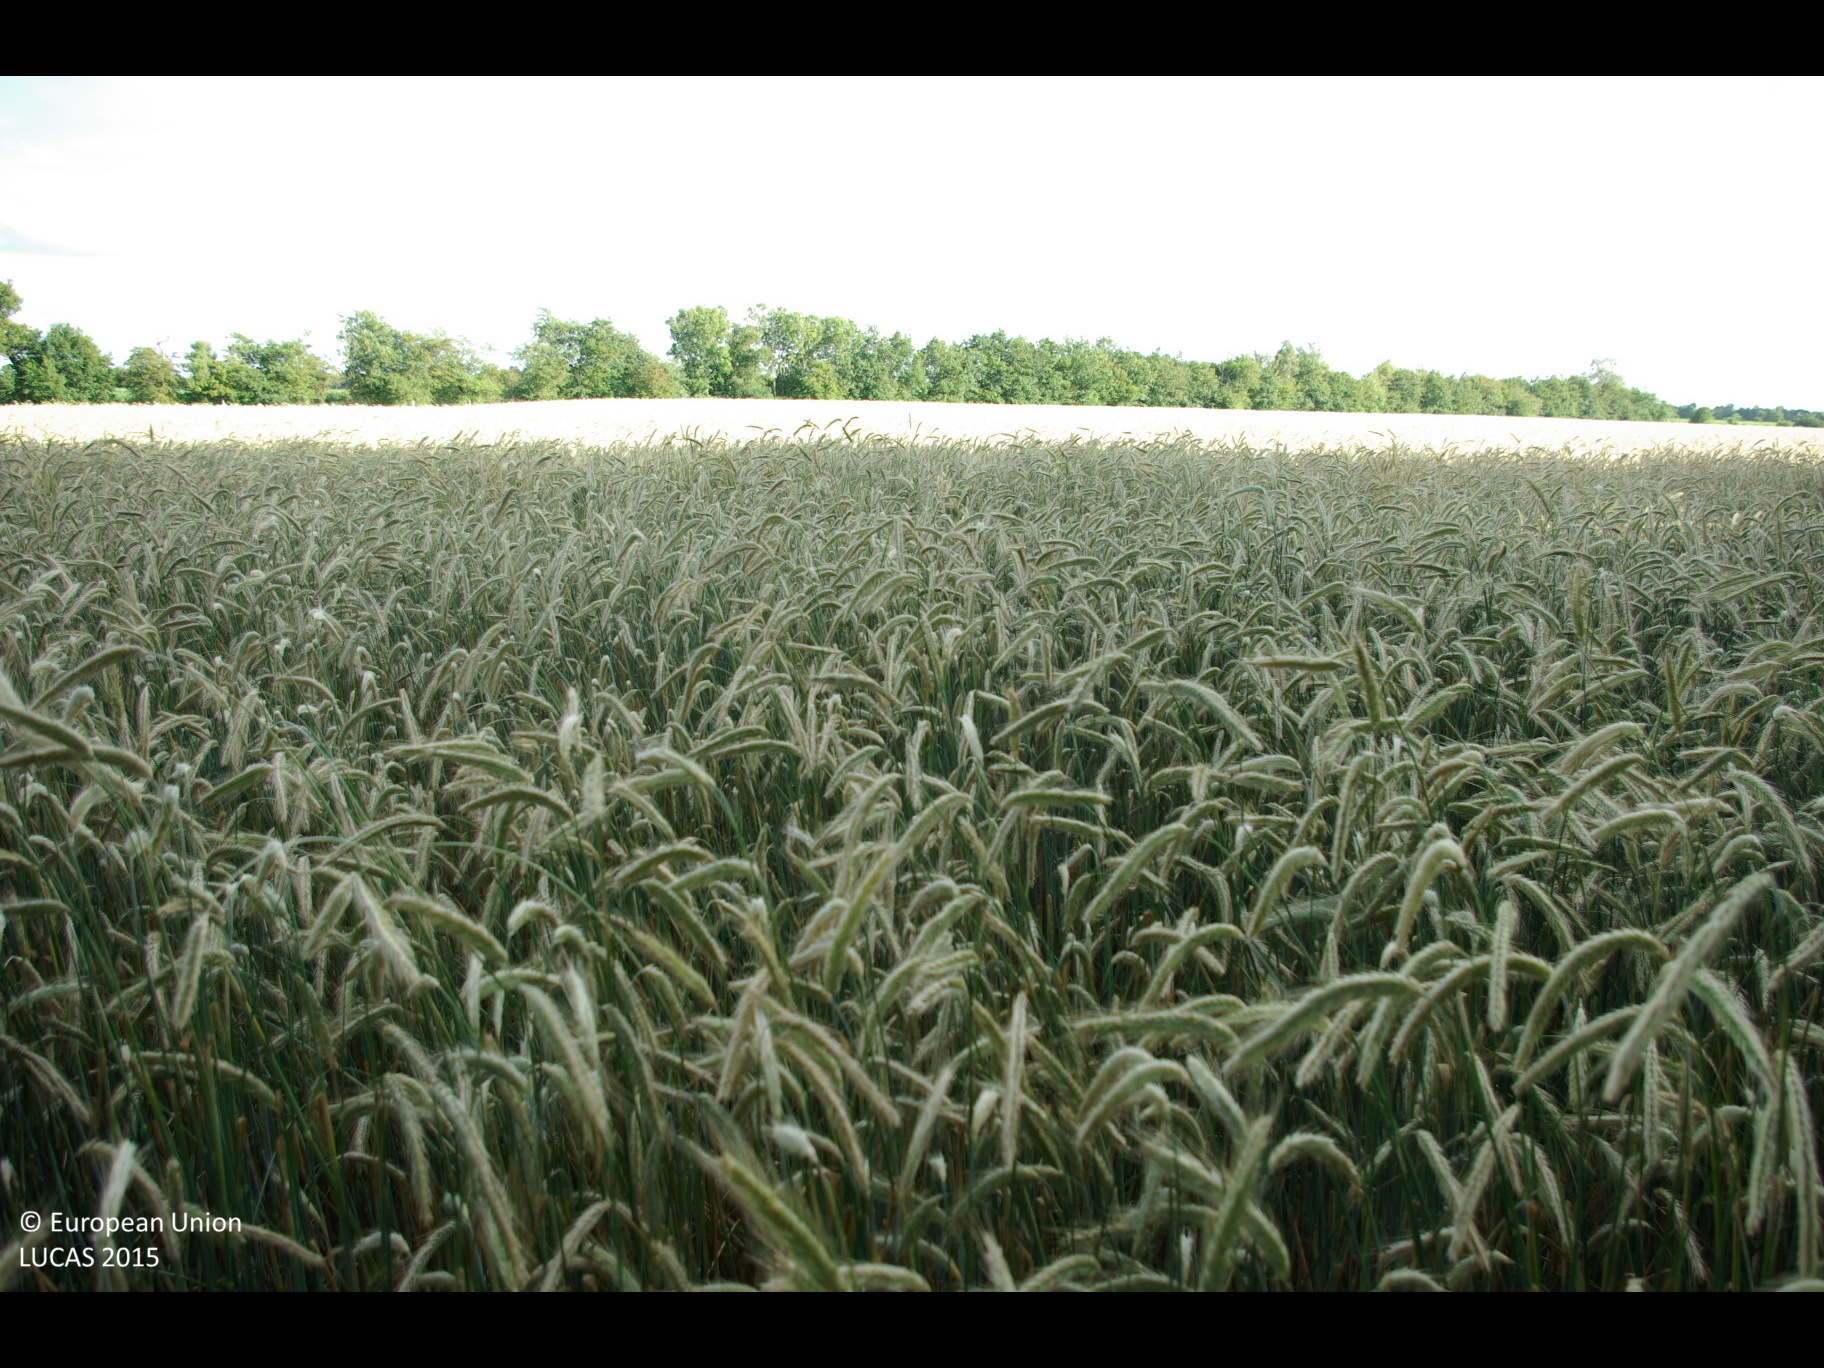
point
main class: Cropland
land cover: Rye
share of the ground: > 75 %
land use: Agriculture (excluding fallow land and kitchen gardens)
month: July
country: DE
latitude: 54.7836
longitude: 9.2697
